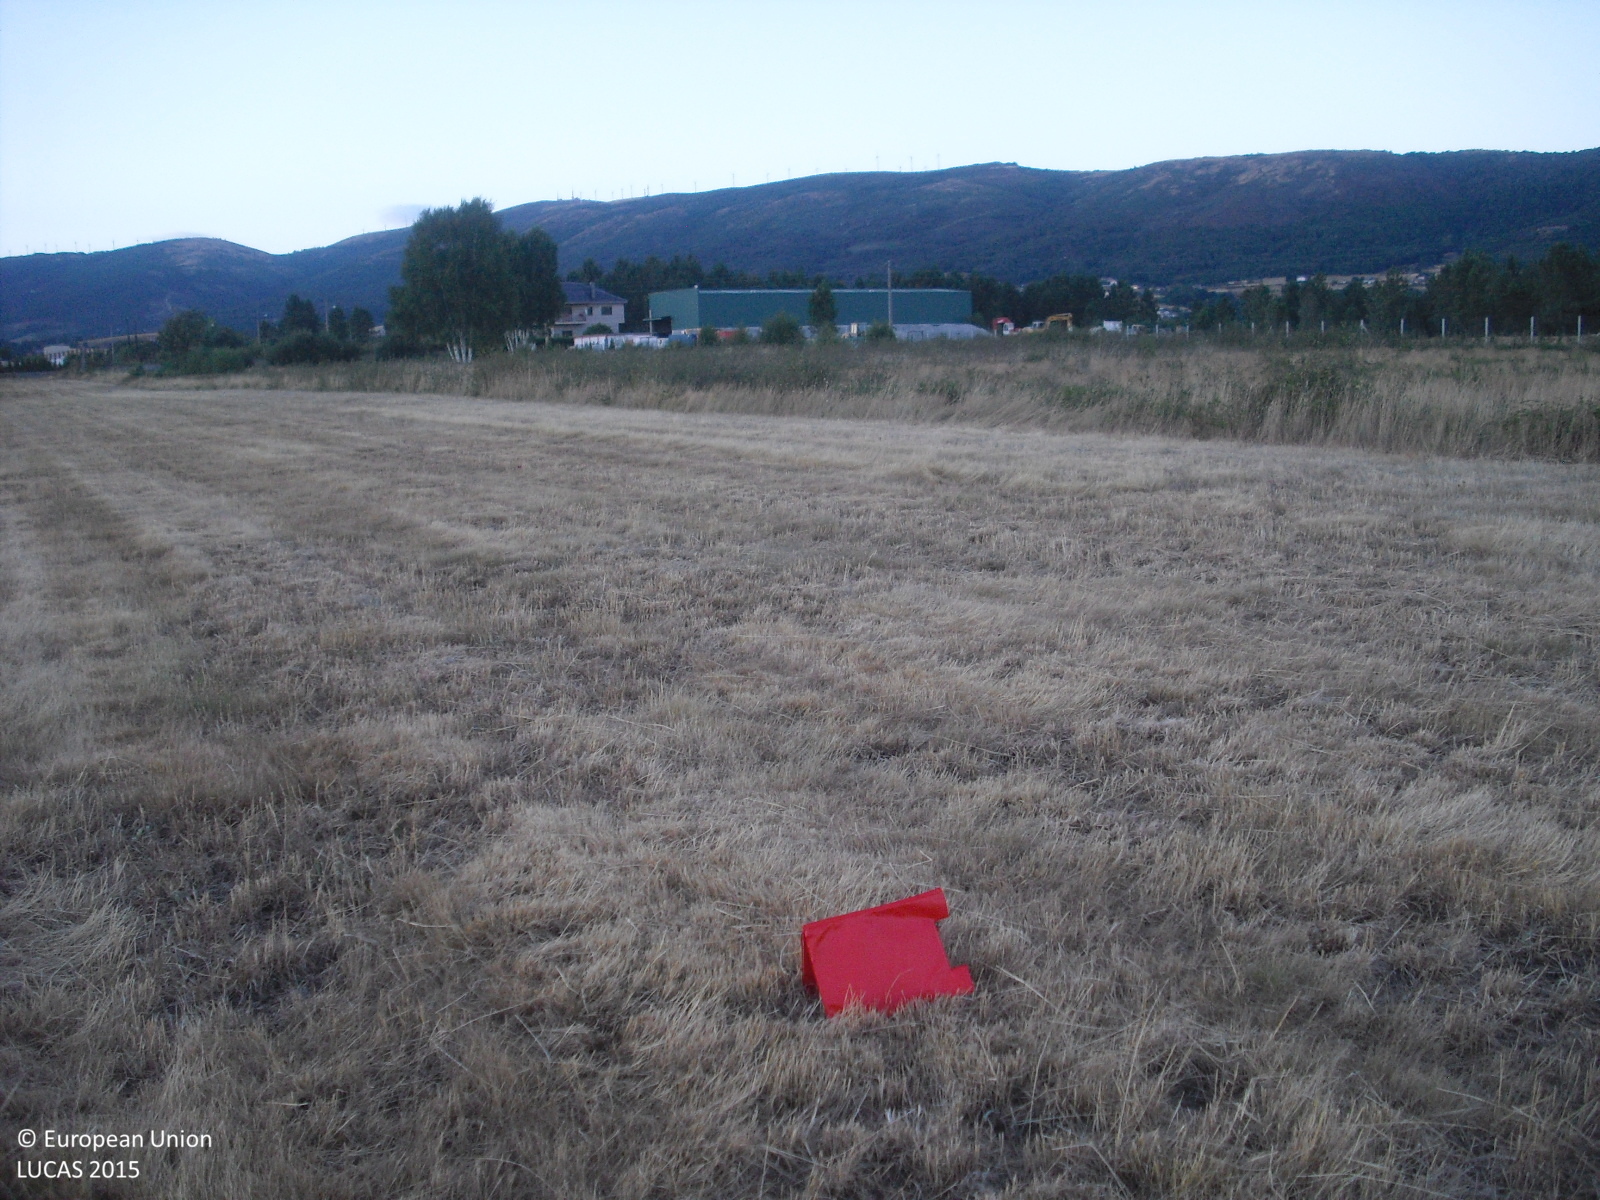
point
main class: Cropland
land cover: Temporary grasslands
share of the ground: > 75 %
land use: Agriculture (excluding fallow land and kitchen gardens)
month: July
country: ES
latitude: 42.2893
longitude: -7.6436
